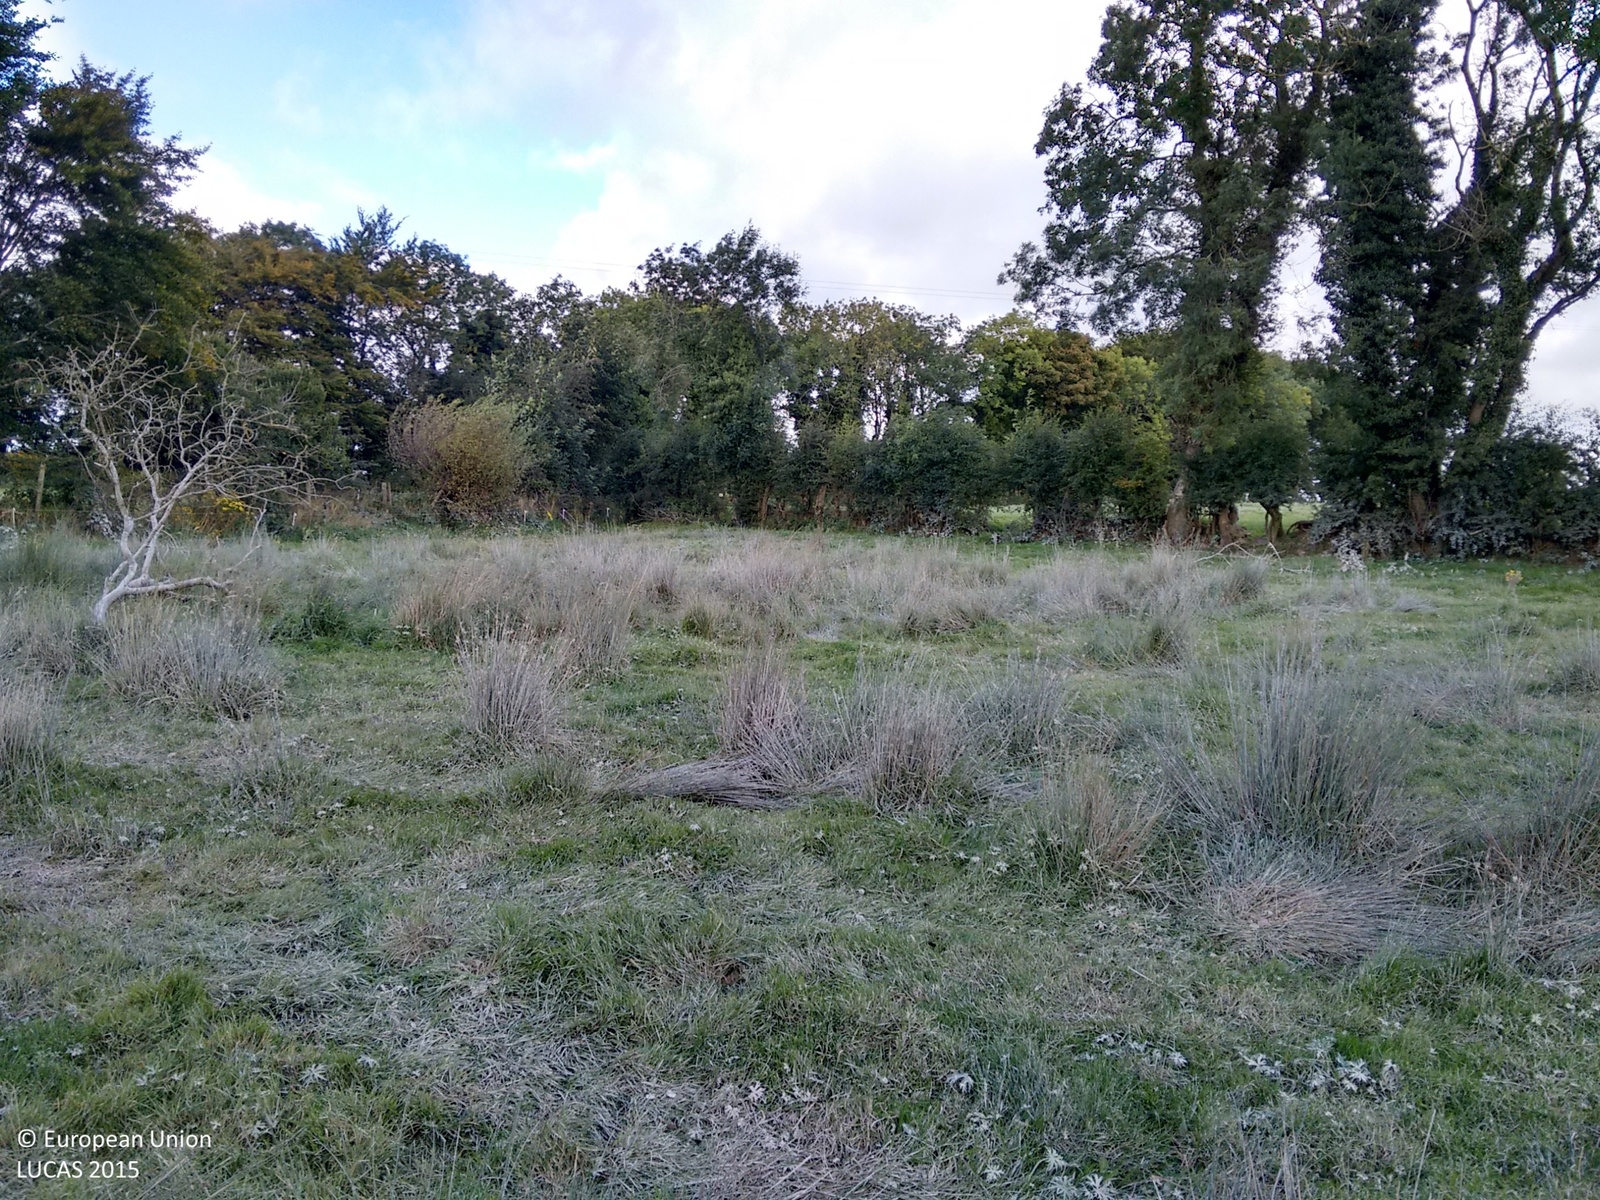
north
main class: Grassland
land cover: Grassland without tree/shrub cover
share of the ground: > 75 %
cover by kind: herbaceous plants 100 %
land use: Agriculture (excluding fallow land and kitchen gardens)
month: September
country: IE
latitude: 54.1987
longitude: -6.8281
